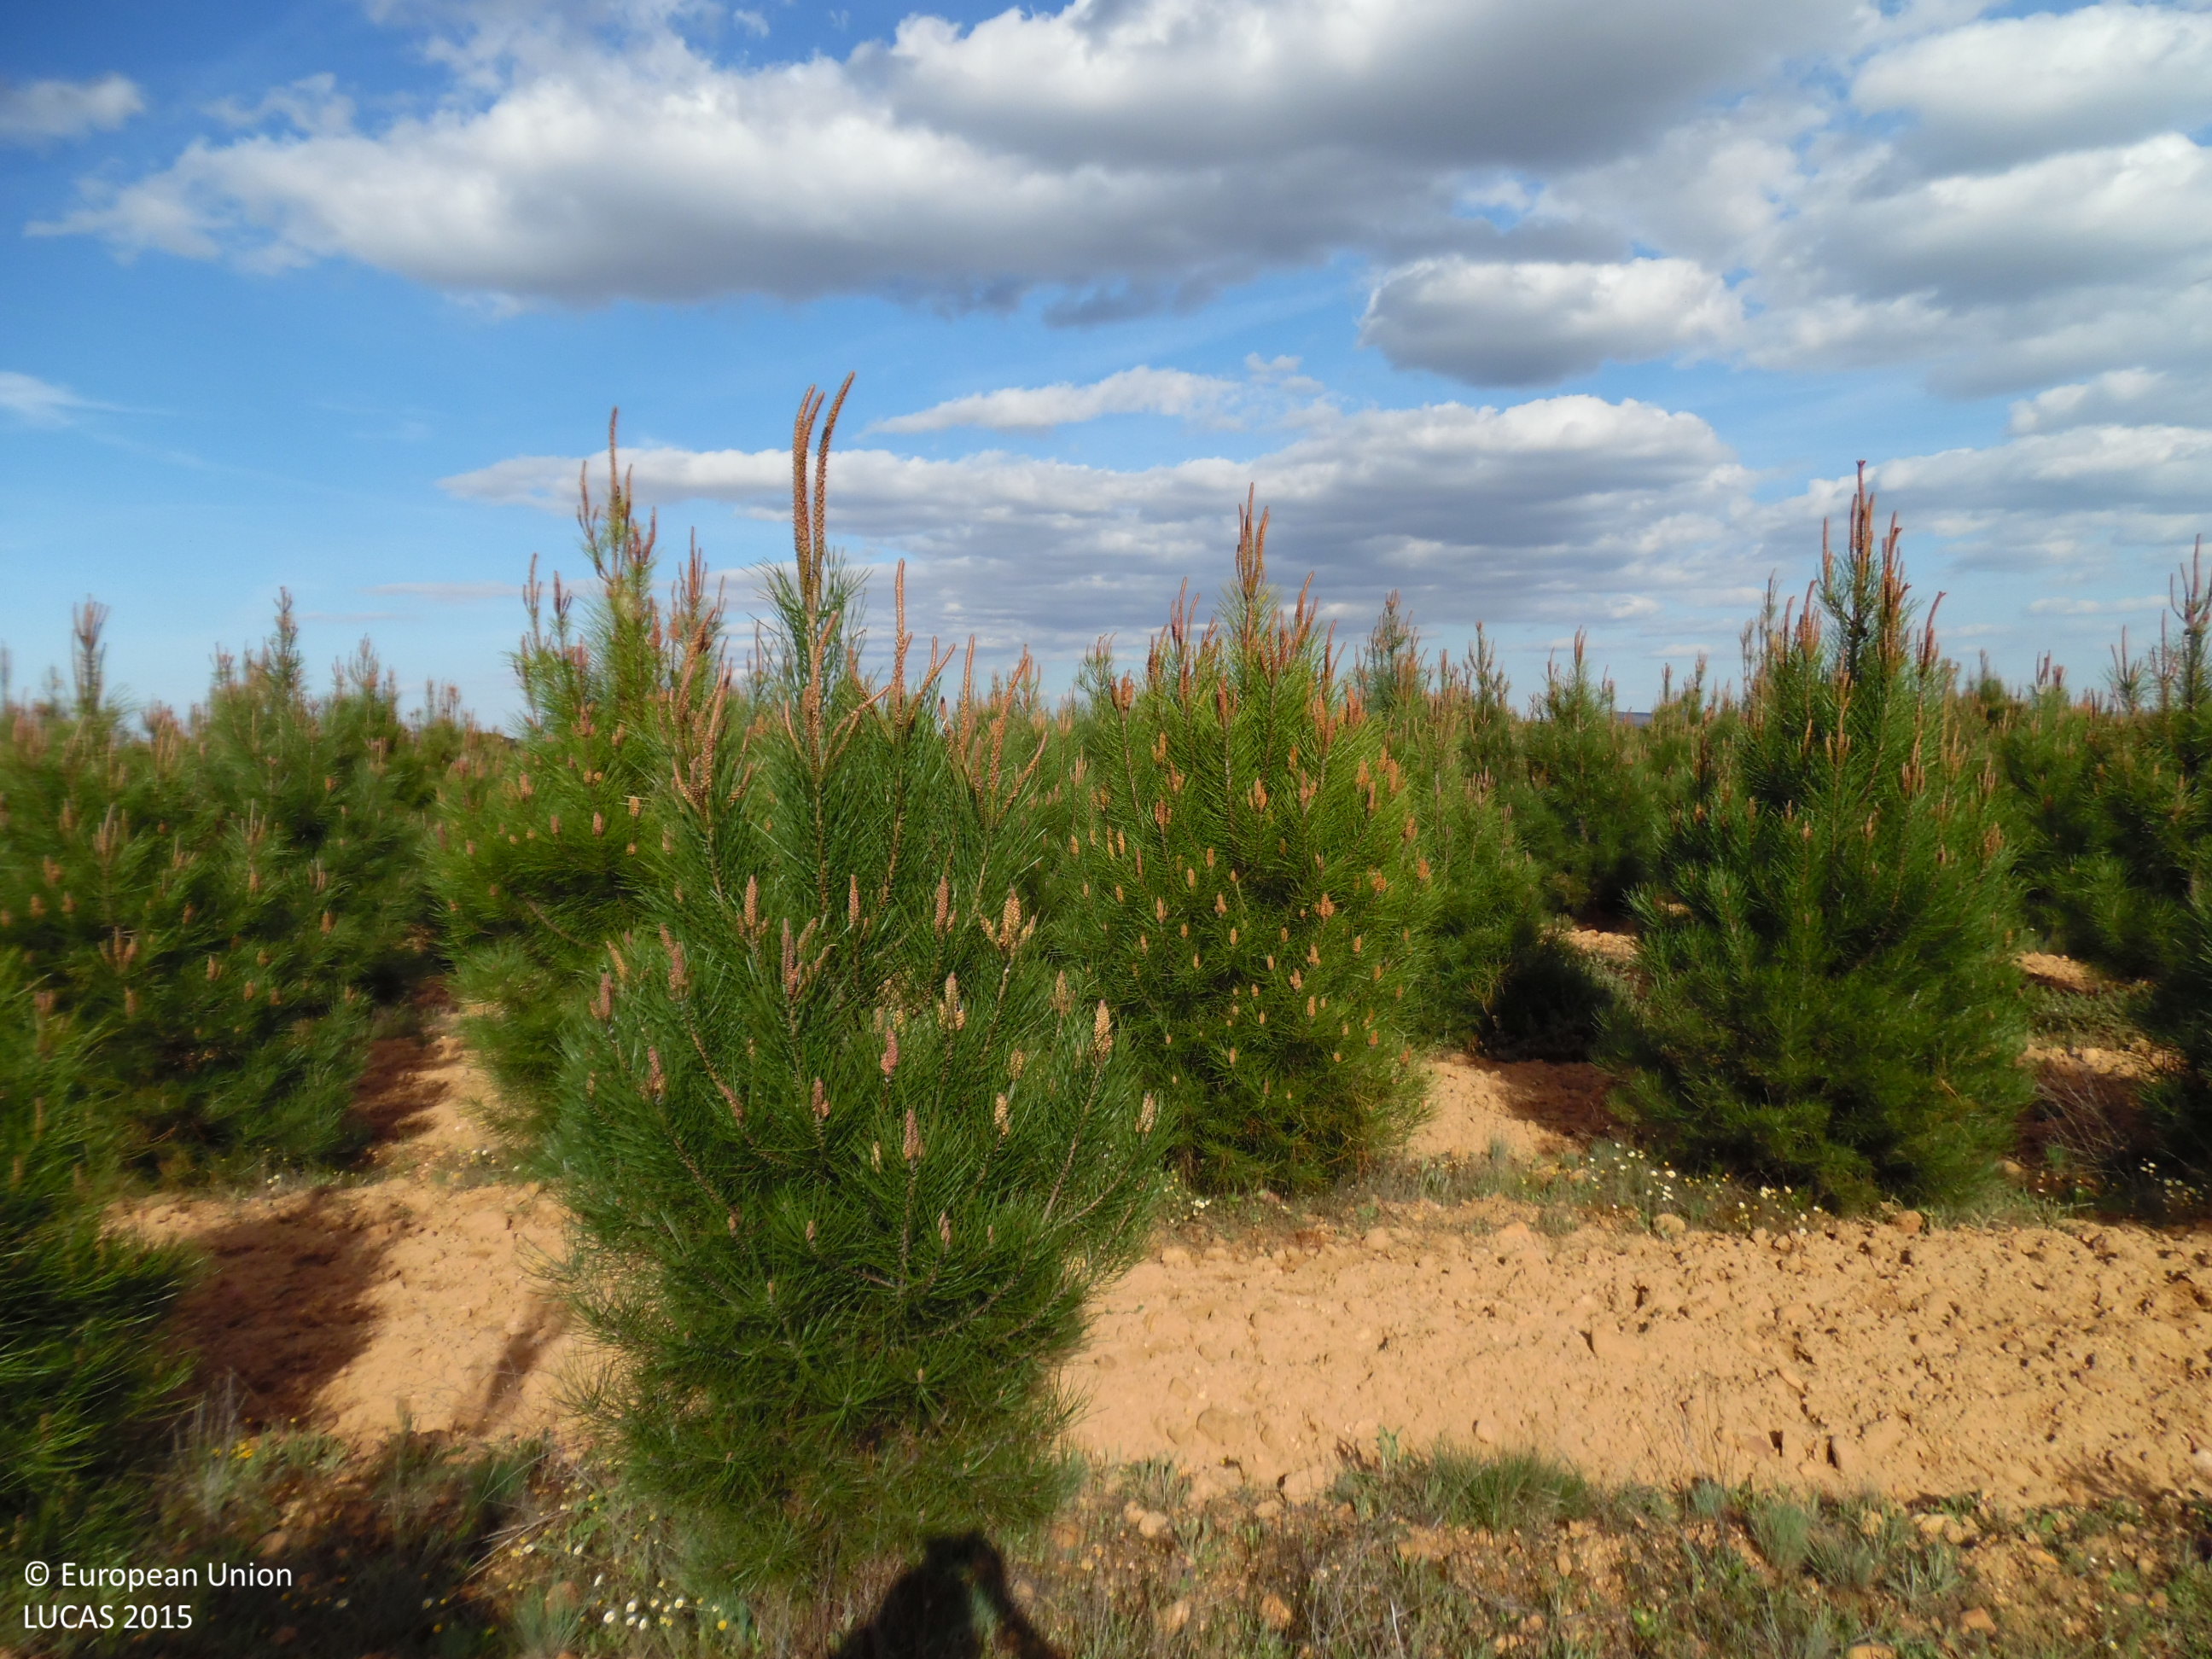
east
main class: Woodland
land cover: Pine dominated coniferous woodland
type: coniferous forest of the mediterranean region
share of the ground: > 75 %
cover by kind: coniferous forest trees 70 %, herbaceous plants 30 %
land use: Forestry
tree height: < 5 m
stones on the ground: < 10 %
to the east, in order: Pine dominated coniferous woodland; Shrubland without tree cover; Barley; Vineyards; Other bare soil
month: April
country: ES
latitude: 42.2617
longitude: -6.0690
